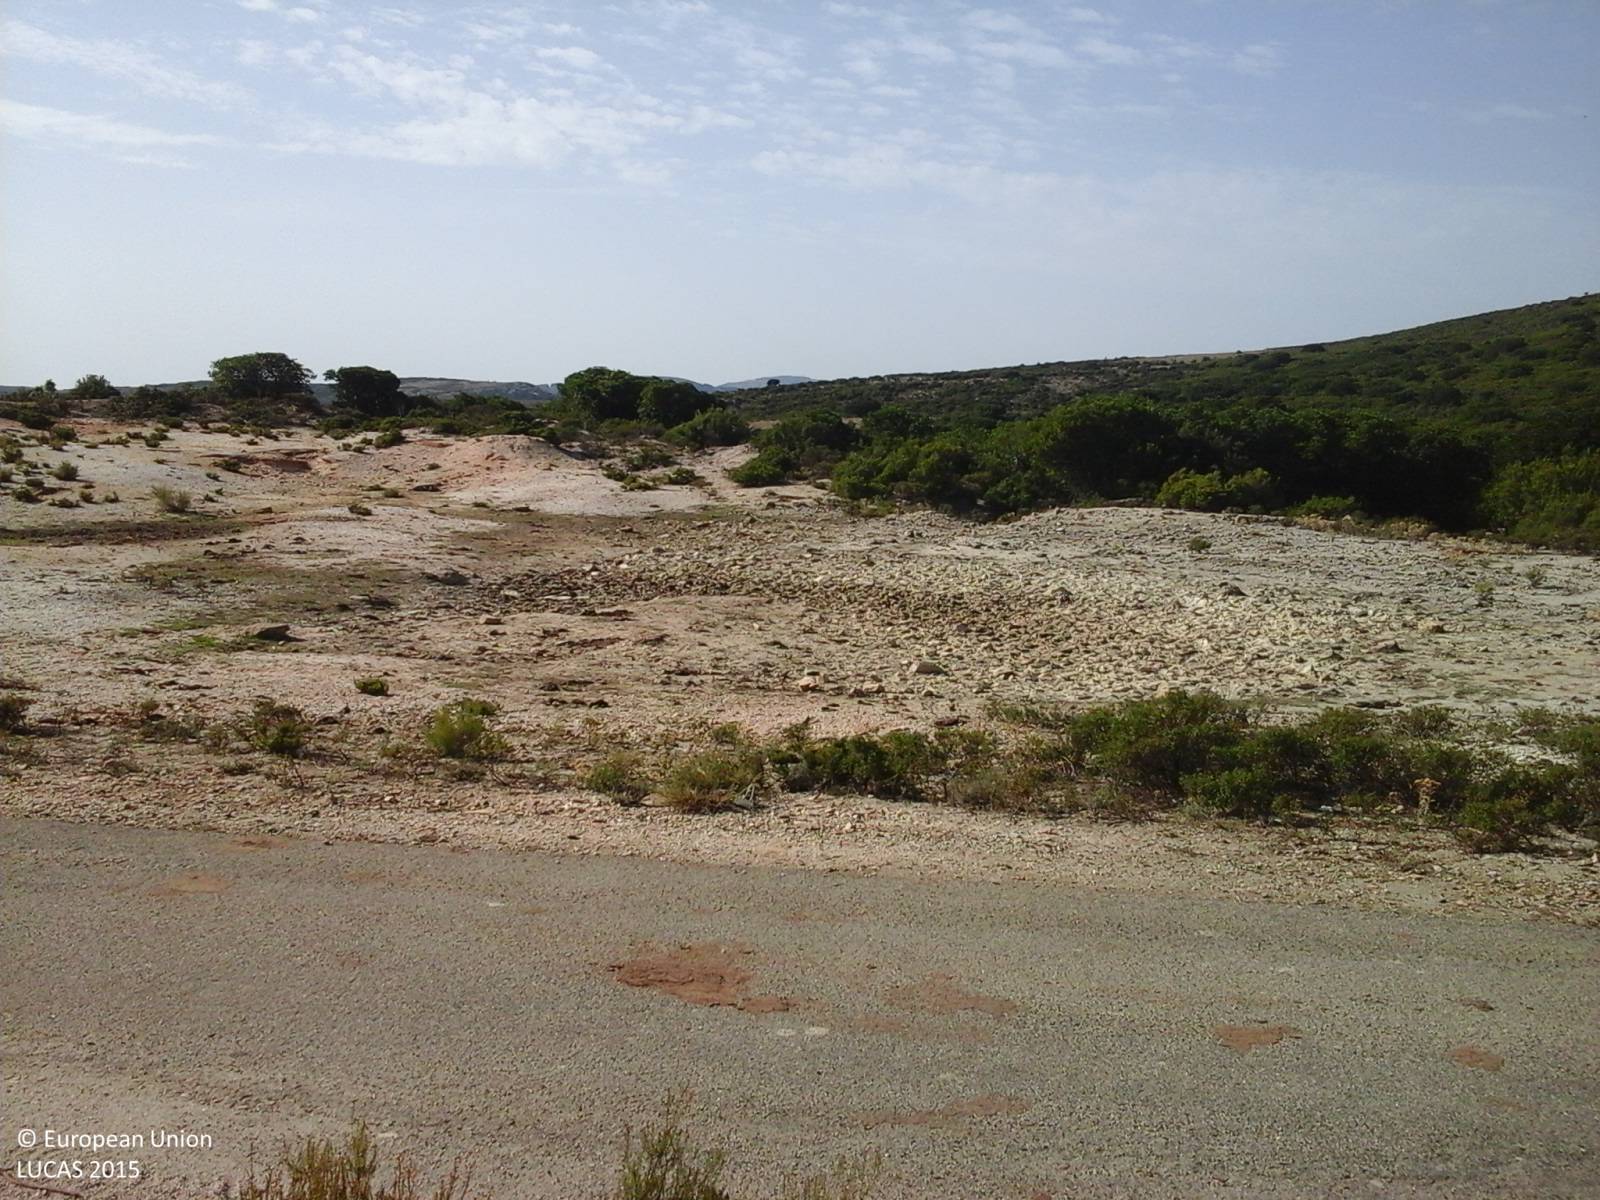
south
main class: Shrubland
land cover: Shrubland without tree cover
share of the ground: > 75 %
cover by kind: shrubs 75 %, herbaceous plants 15 %, consolidated bare surface 5 %, unconsolidated bare surface 5 %
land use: Agriculture (excluding fallow land and kitchen gardens)
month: September
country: IT
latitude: 39.8849
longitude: 9.3372
